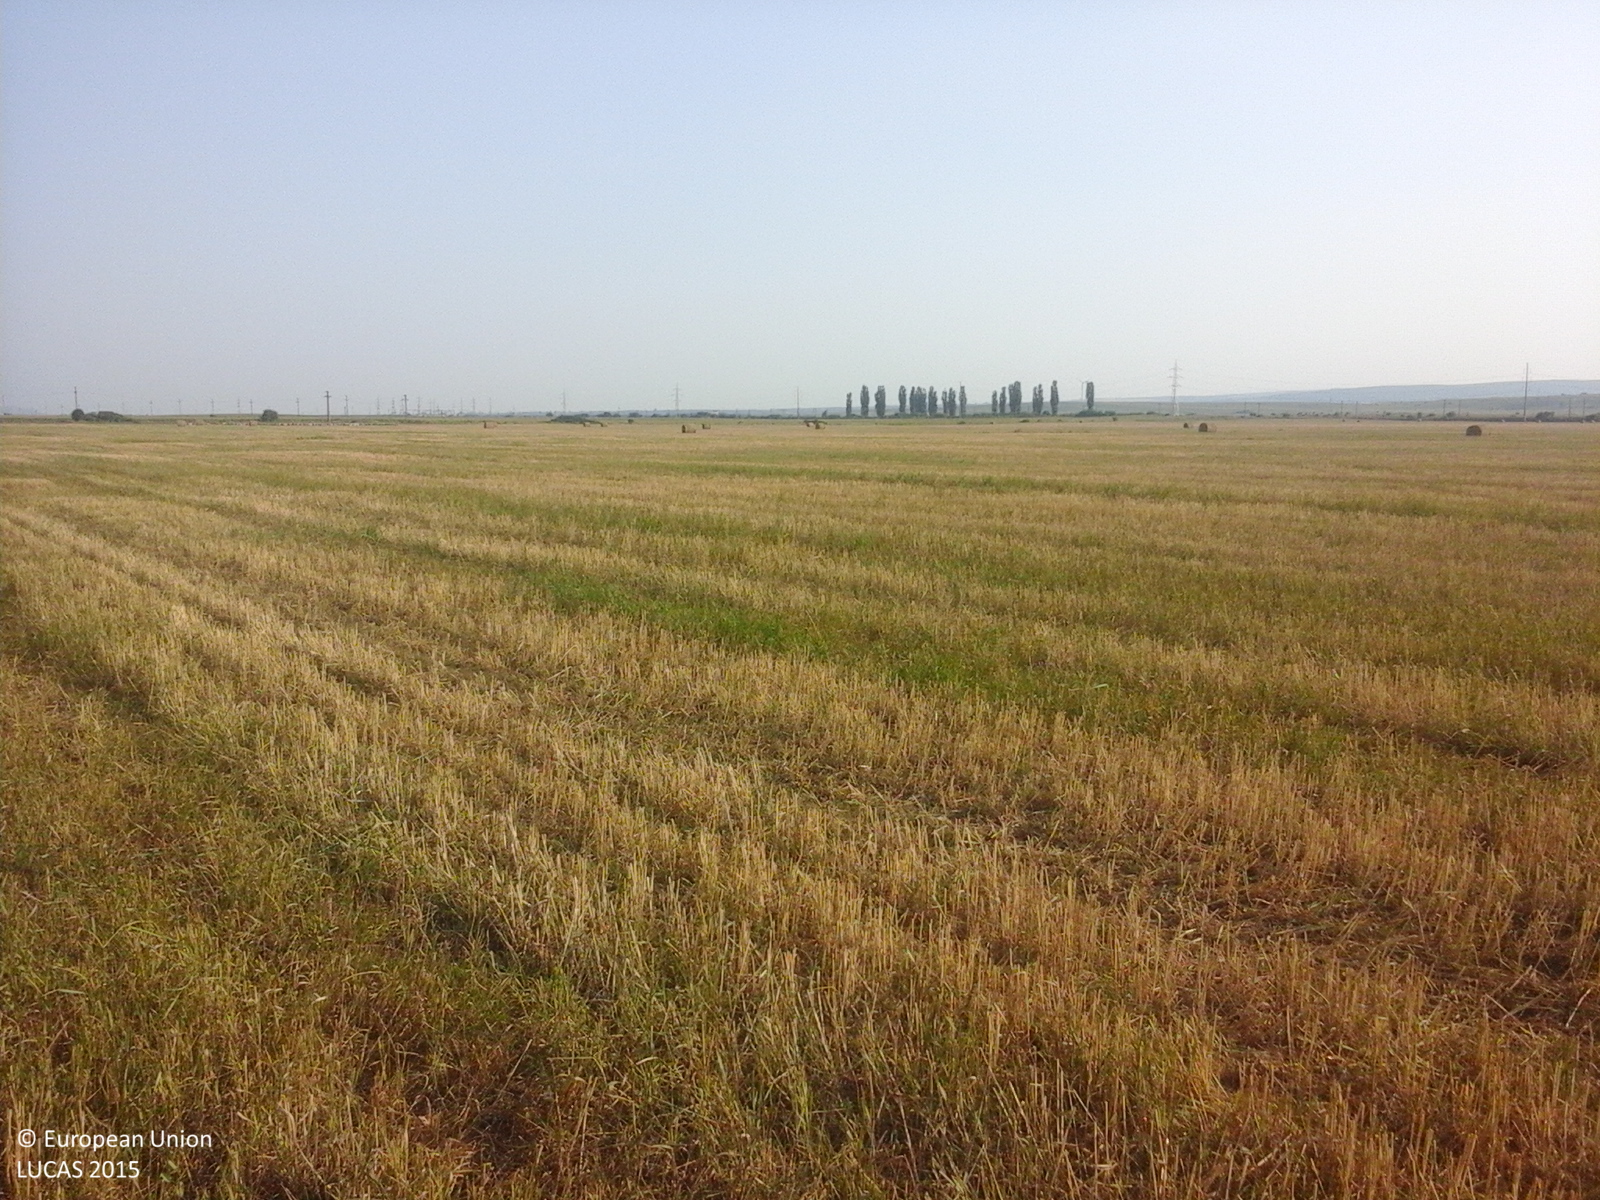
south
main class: Cropland
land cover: Common wheat
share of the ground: 50 - 75 %
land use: Agriculture (excluding fallow land and kitchen gardens)
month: July
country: RO
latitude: 46.1662
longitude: 27.1546
